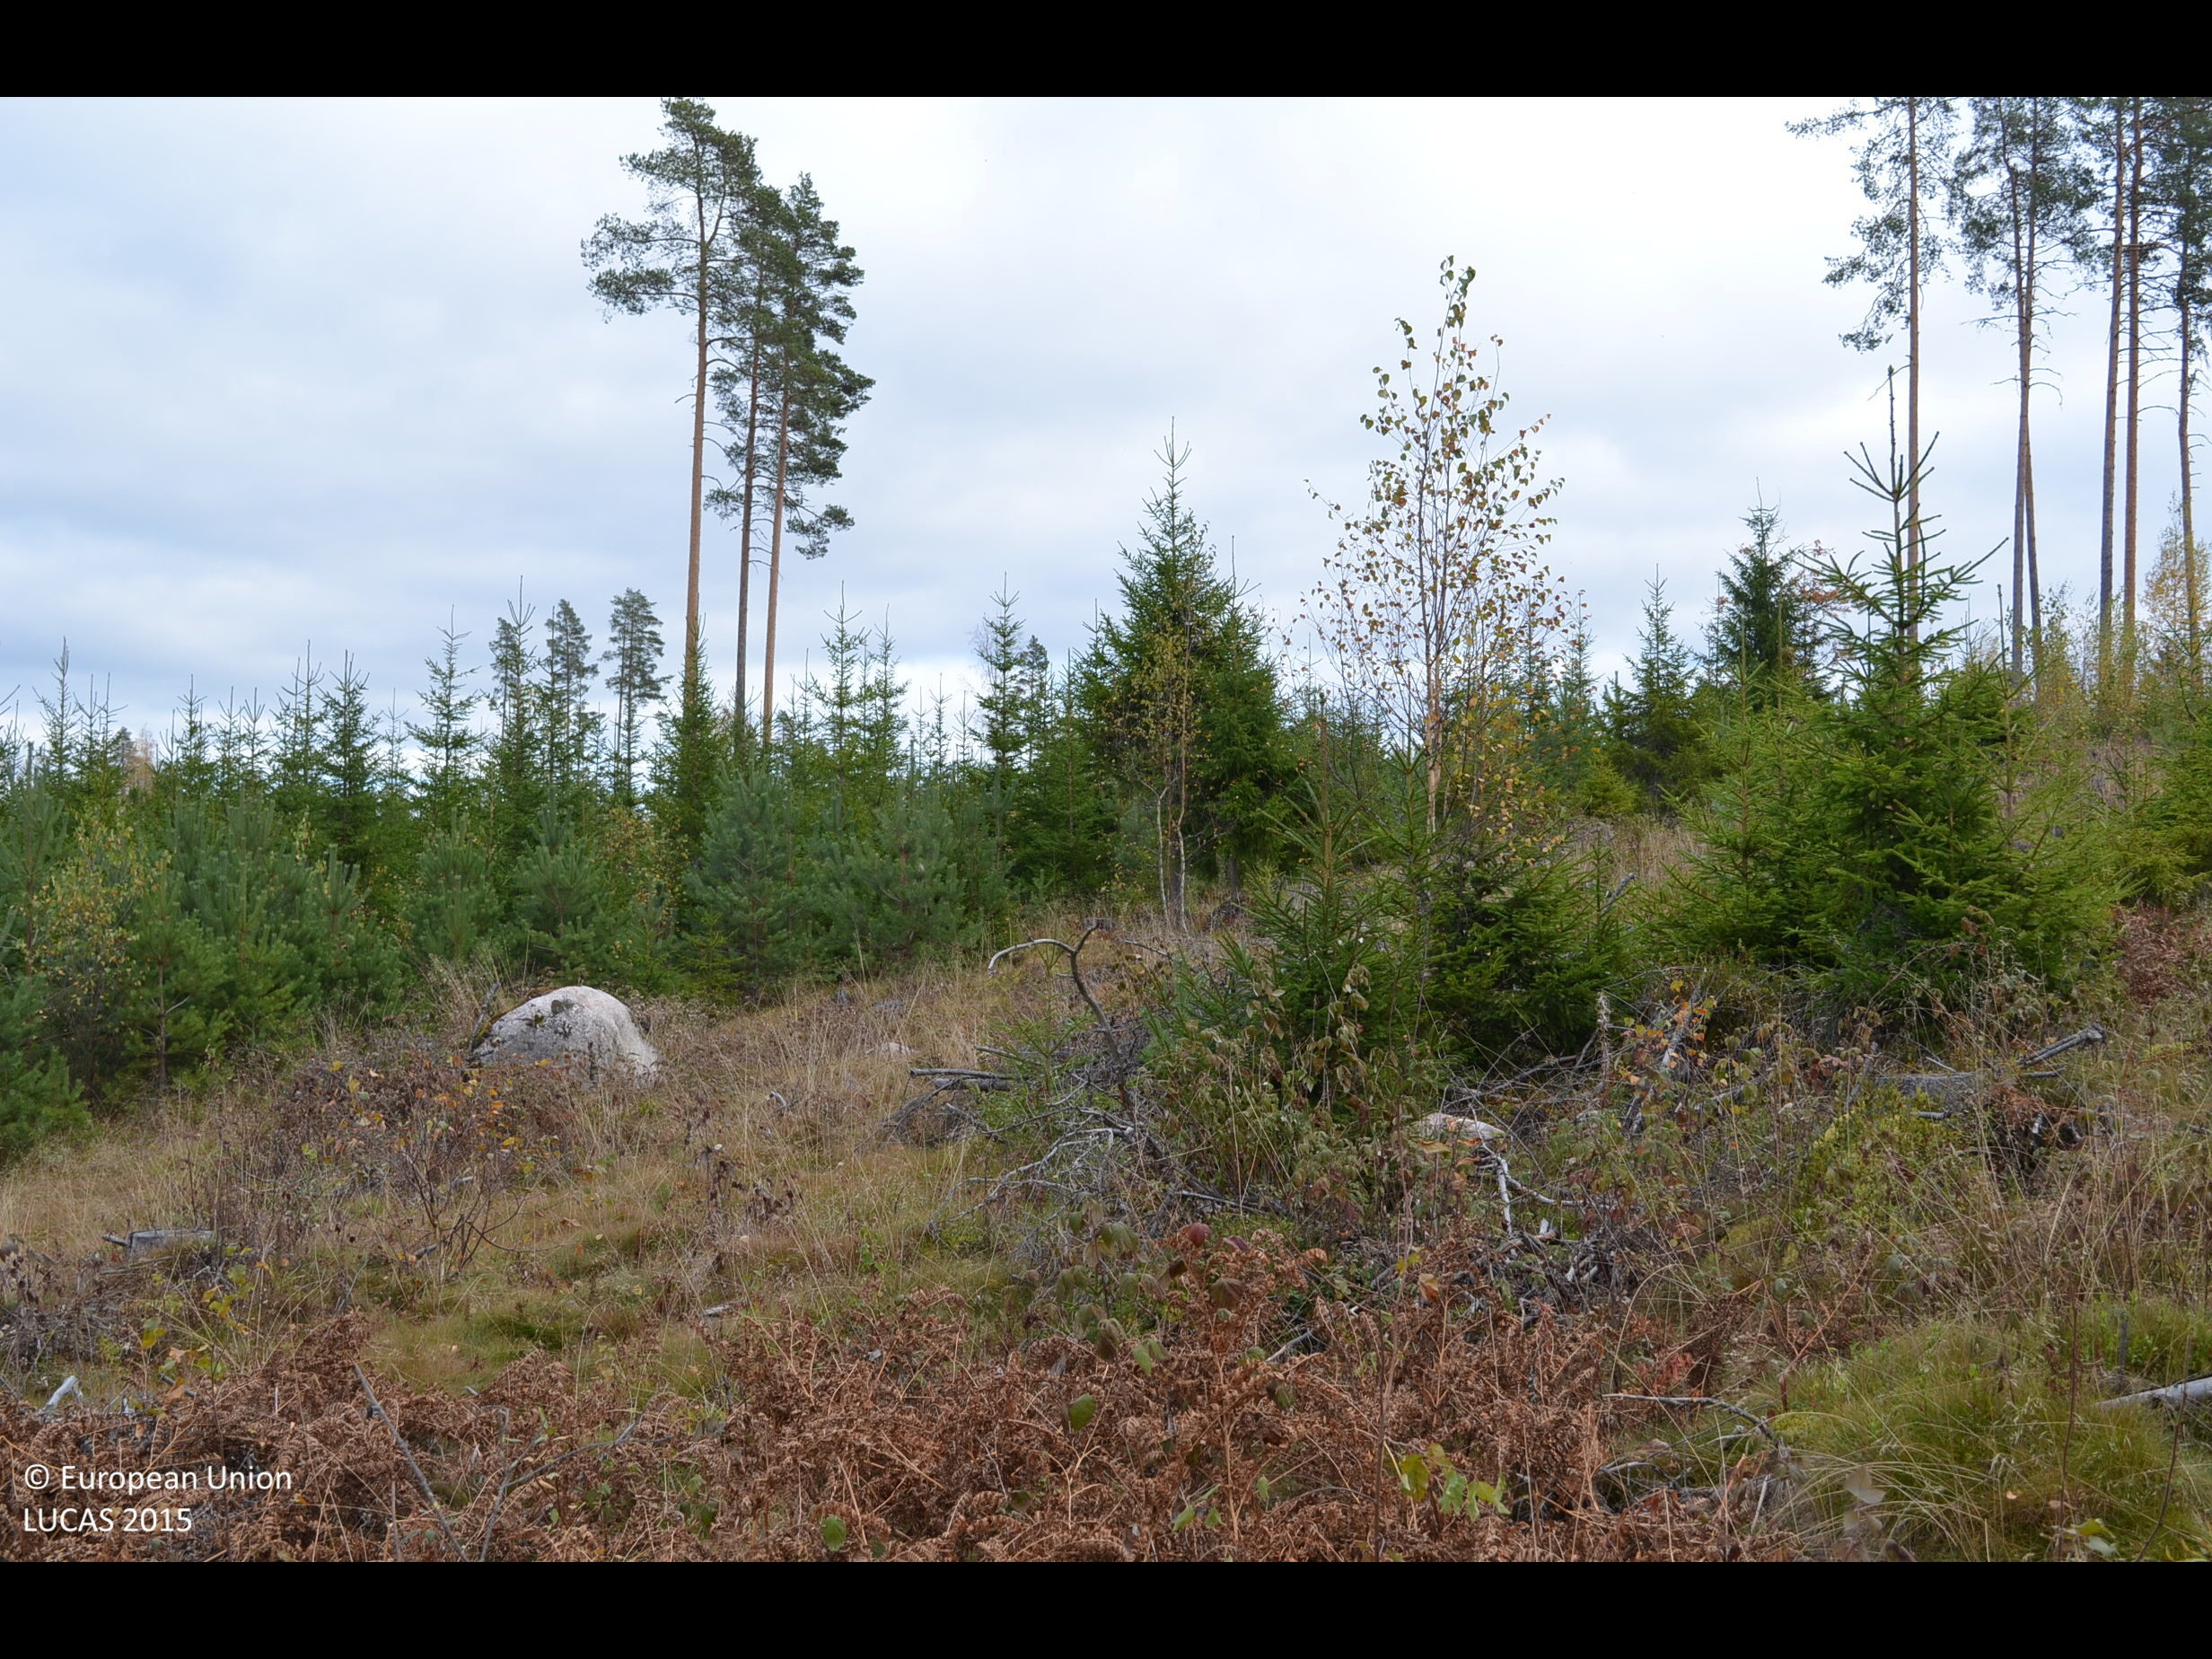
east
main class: Woodland
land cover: Other mixed woodland
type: boreal forest
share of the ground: 50 - 75 %
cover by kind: coniferous forest trees 45 %, shrubs 20 %, herbaceous plants 20 %, broadleaved forest trees 15 %
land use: Forestry
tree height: < 5 m
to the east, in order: Other mixed woodland; Spruce dominated mixed woodland; Other coniferous woodland; Other mixed woodland
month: October
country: FI
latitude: 61.6808
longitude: 23.9755
